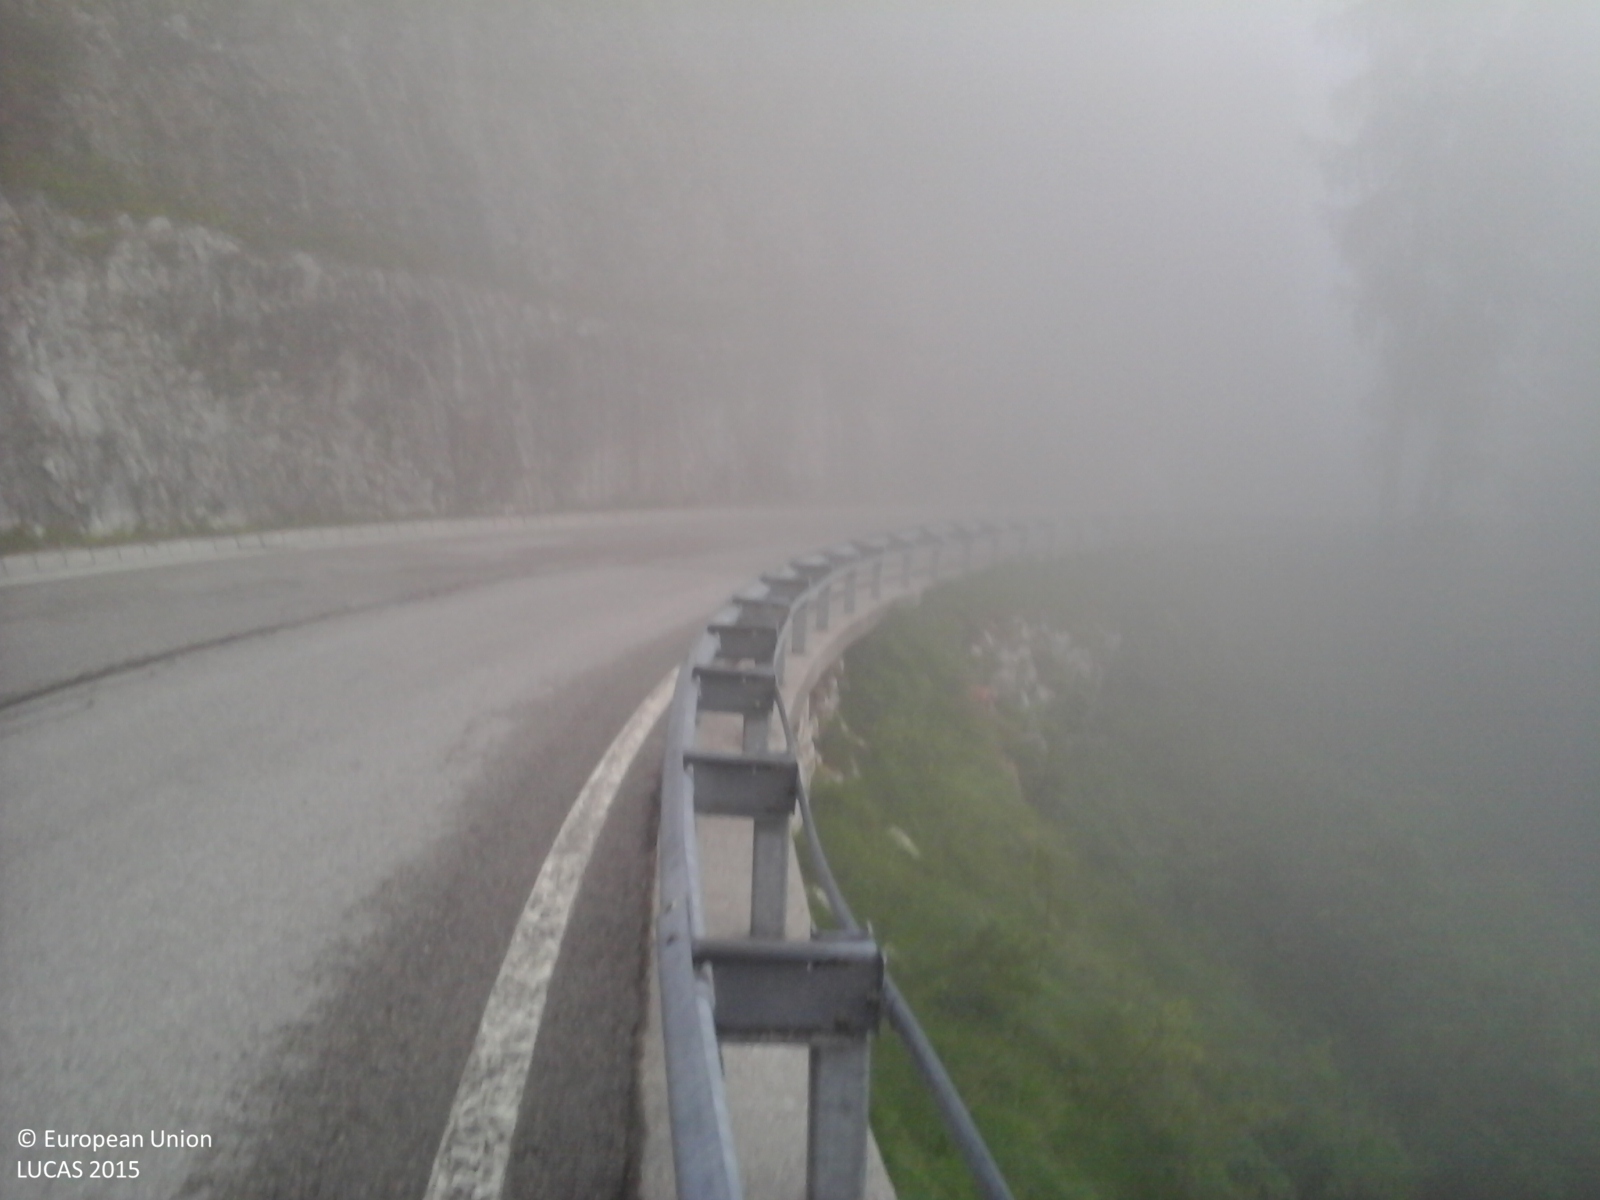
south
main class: Woodland
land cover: Other coniferous woodland
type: alpine coniferous forest
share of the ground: > 75 %
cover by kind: coniferous forest trees 80 %, herbaceous plants 20 %
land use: Forestry
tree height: > 5 m
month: May
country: IT
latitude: 46.1044
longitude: 11.6407
